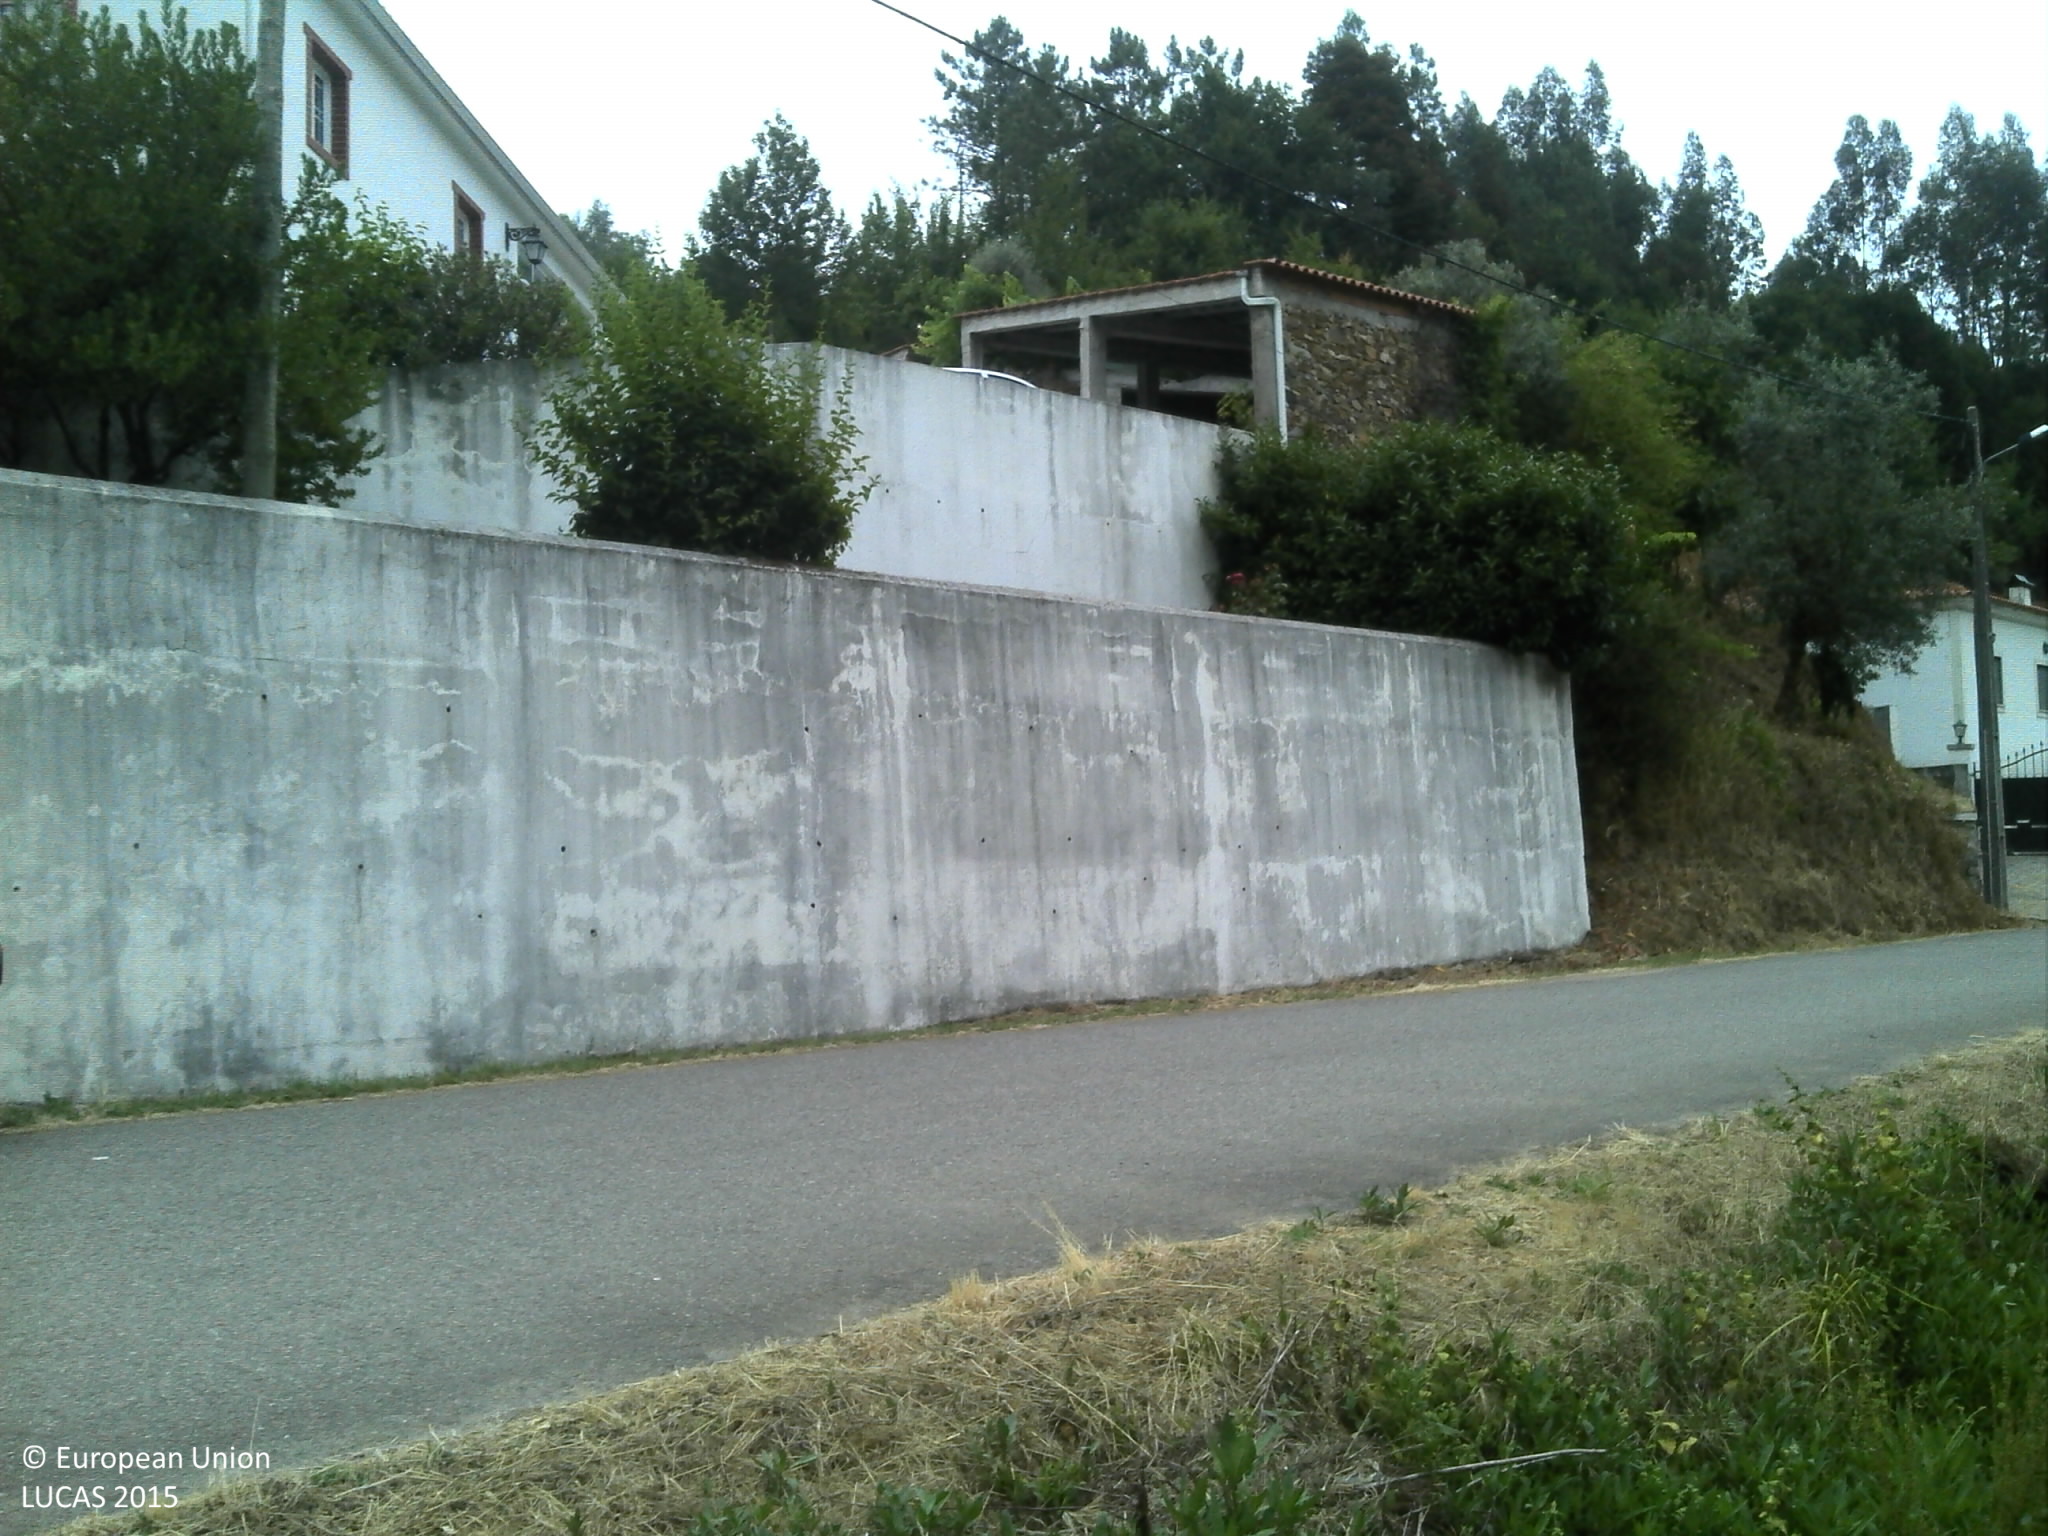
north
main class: Grassland
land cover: Grassland without tree/shrub cover
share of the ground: > 75 %
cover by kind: herbaceous plants 75 %, consolidated bare surface 15 %, unconsolidated bare surface 10 %
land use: Agriculture (excluding fallow land and kitchen gardens)
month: July
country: PT
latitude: 40.3820
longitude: -8.2813
